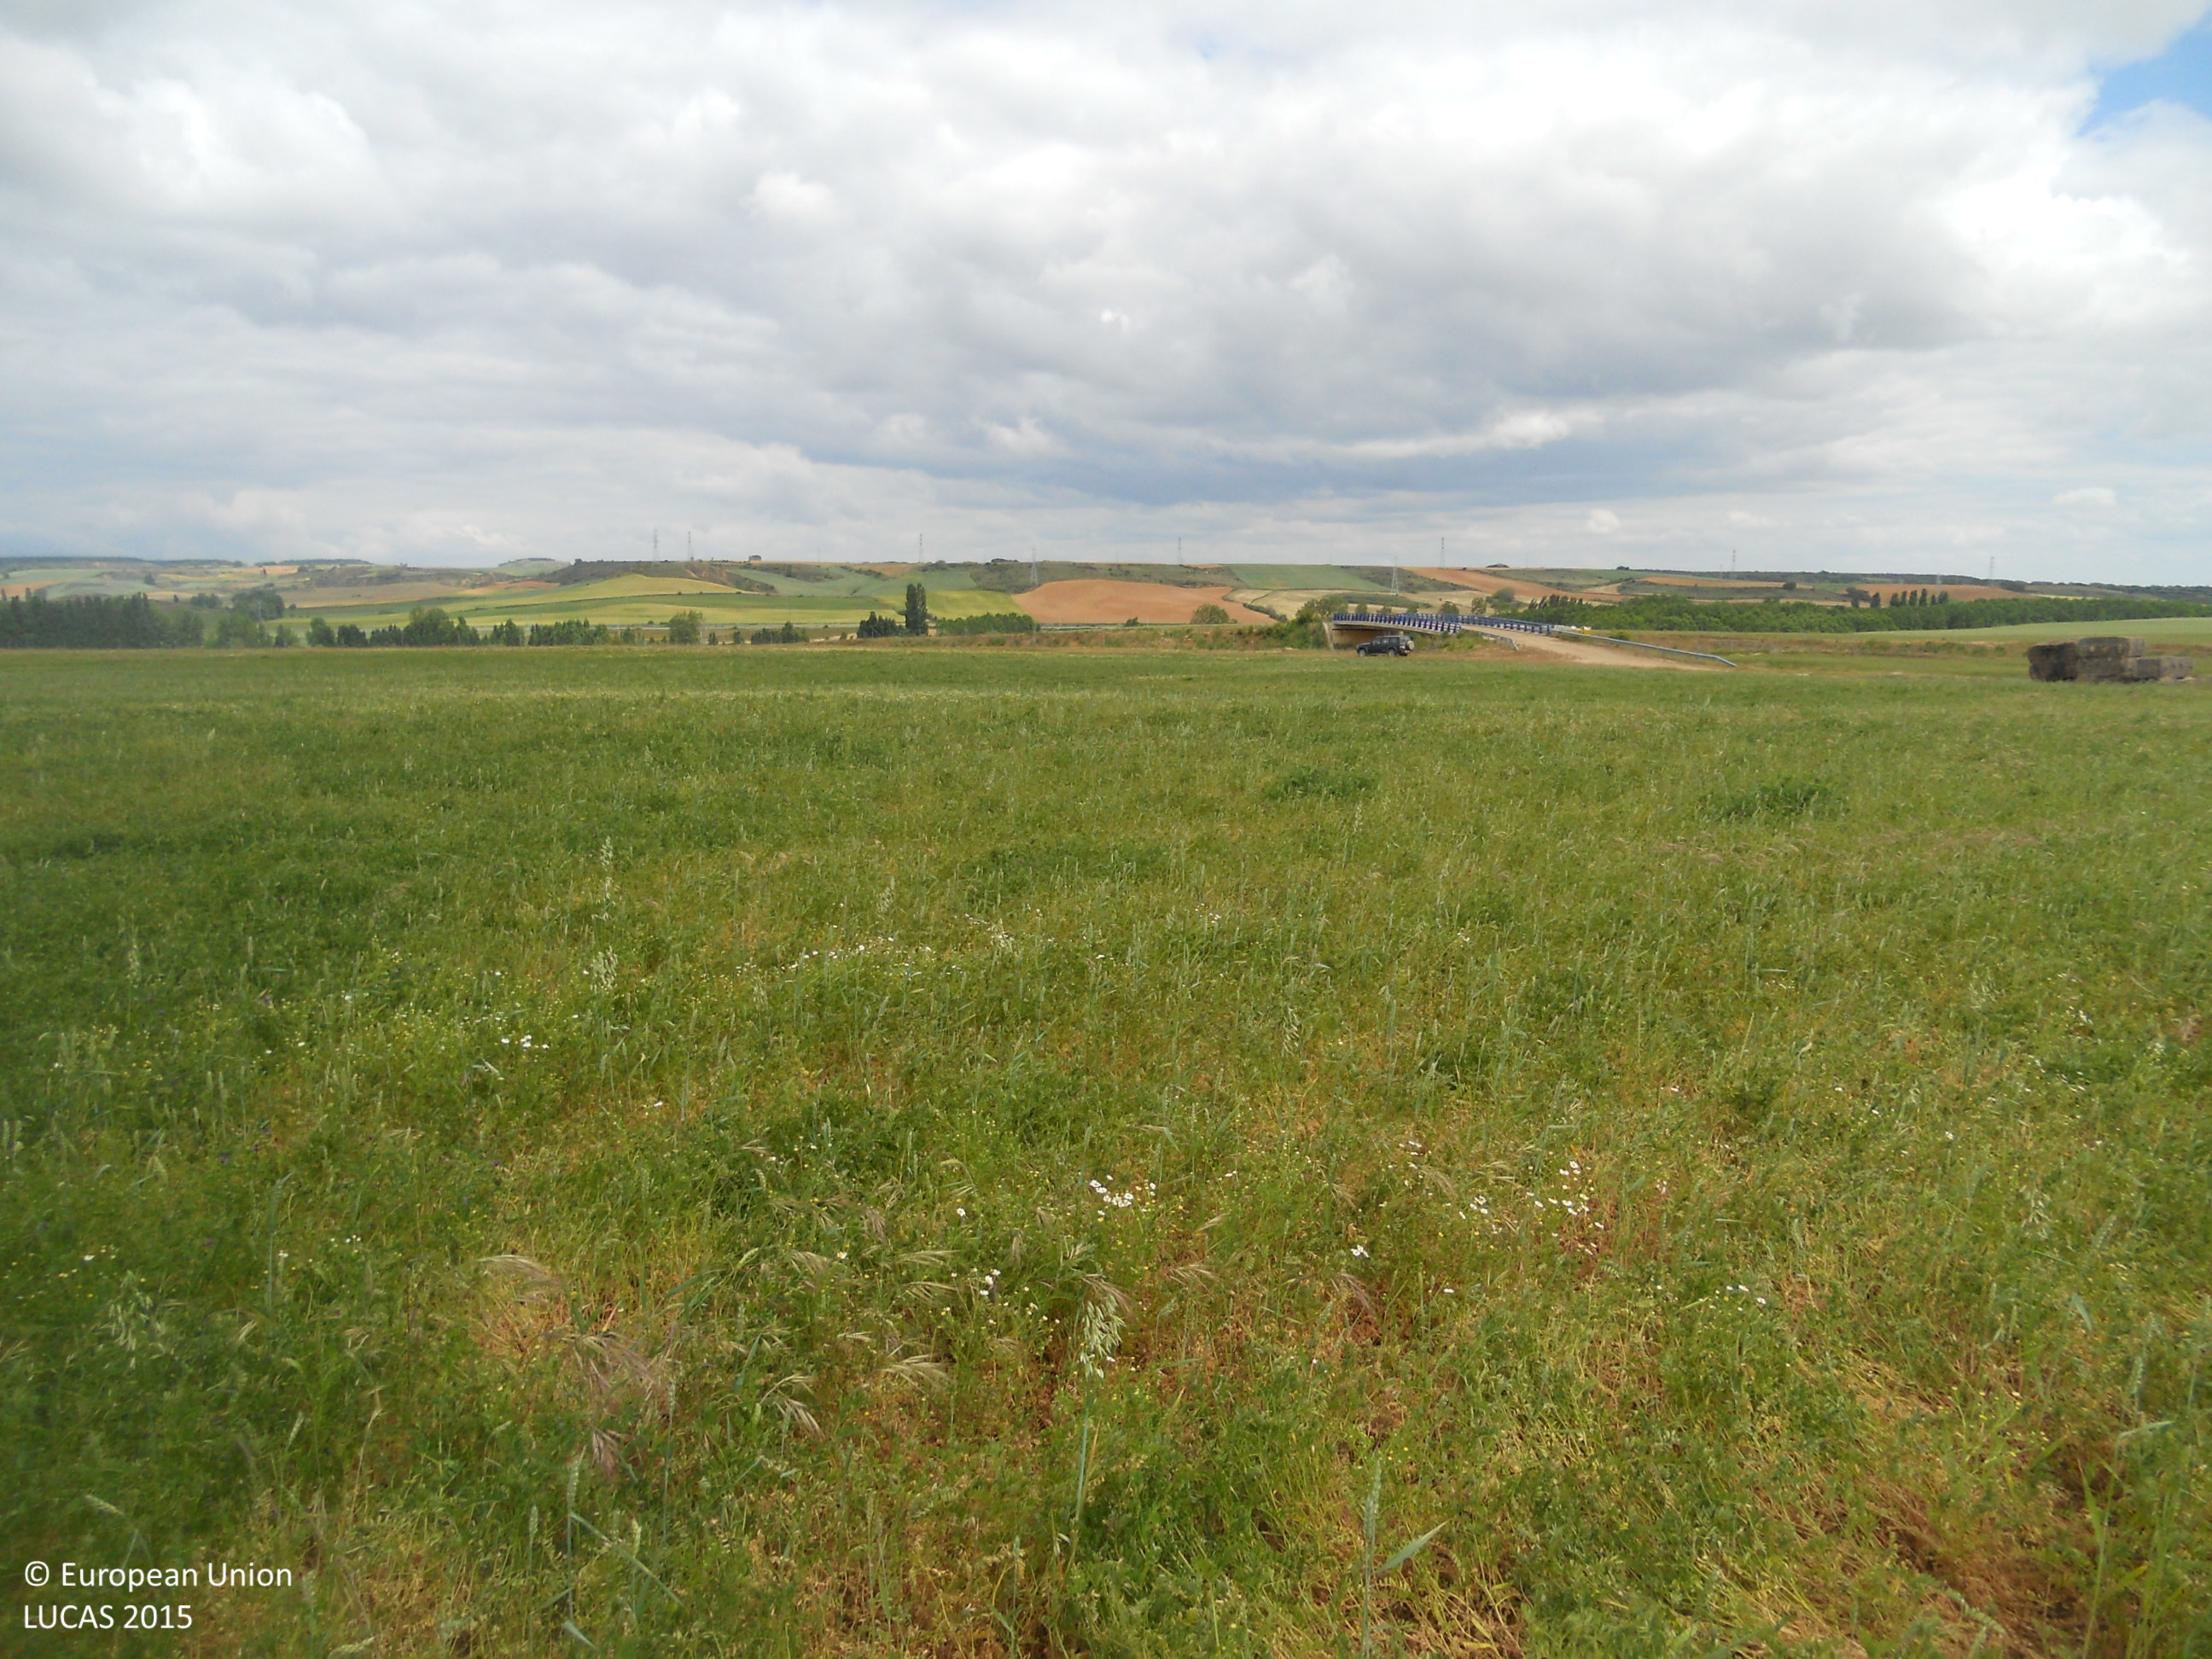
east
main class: Cropland
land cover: Dry pulses
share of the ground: > 75 %
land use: Agriculture (excluding fallow land and kitchen gardens)
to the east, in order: Dry pulses; Grassland without tree/shrub cover; Tracks; Grassland without tree/shrub cover; Fences; Grass margins; Ditches and canals; Grassland without tree/shrub cover; Paved roads, cycling and walking lanes; Artificial constructions in urban areas; Paved roads, cycling and walking lanes; Grassland without tree/shrub cover; Fences; Grassland without tree/shrub cover
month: May
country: ES
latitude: 42.4632
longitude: -4.3870
